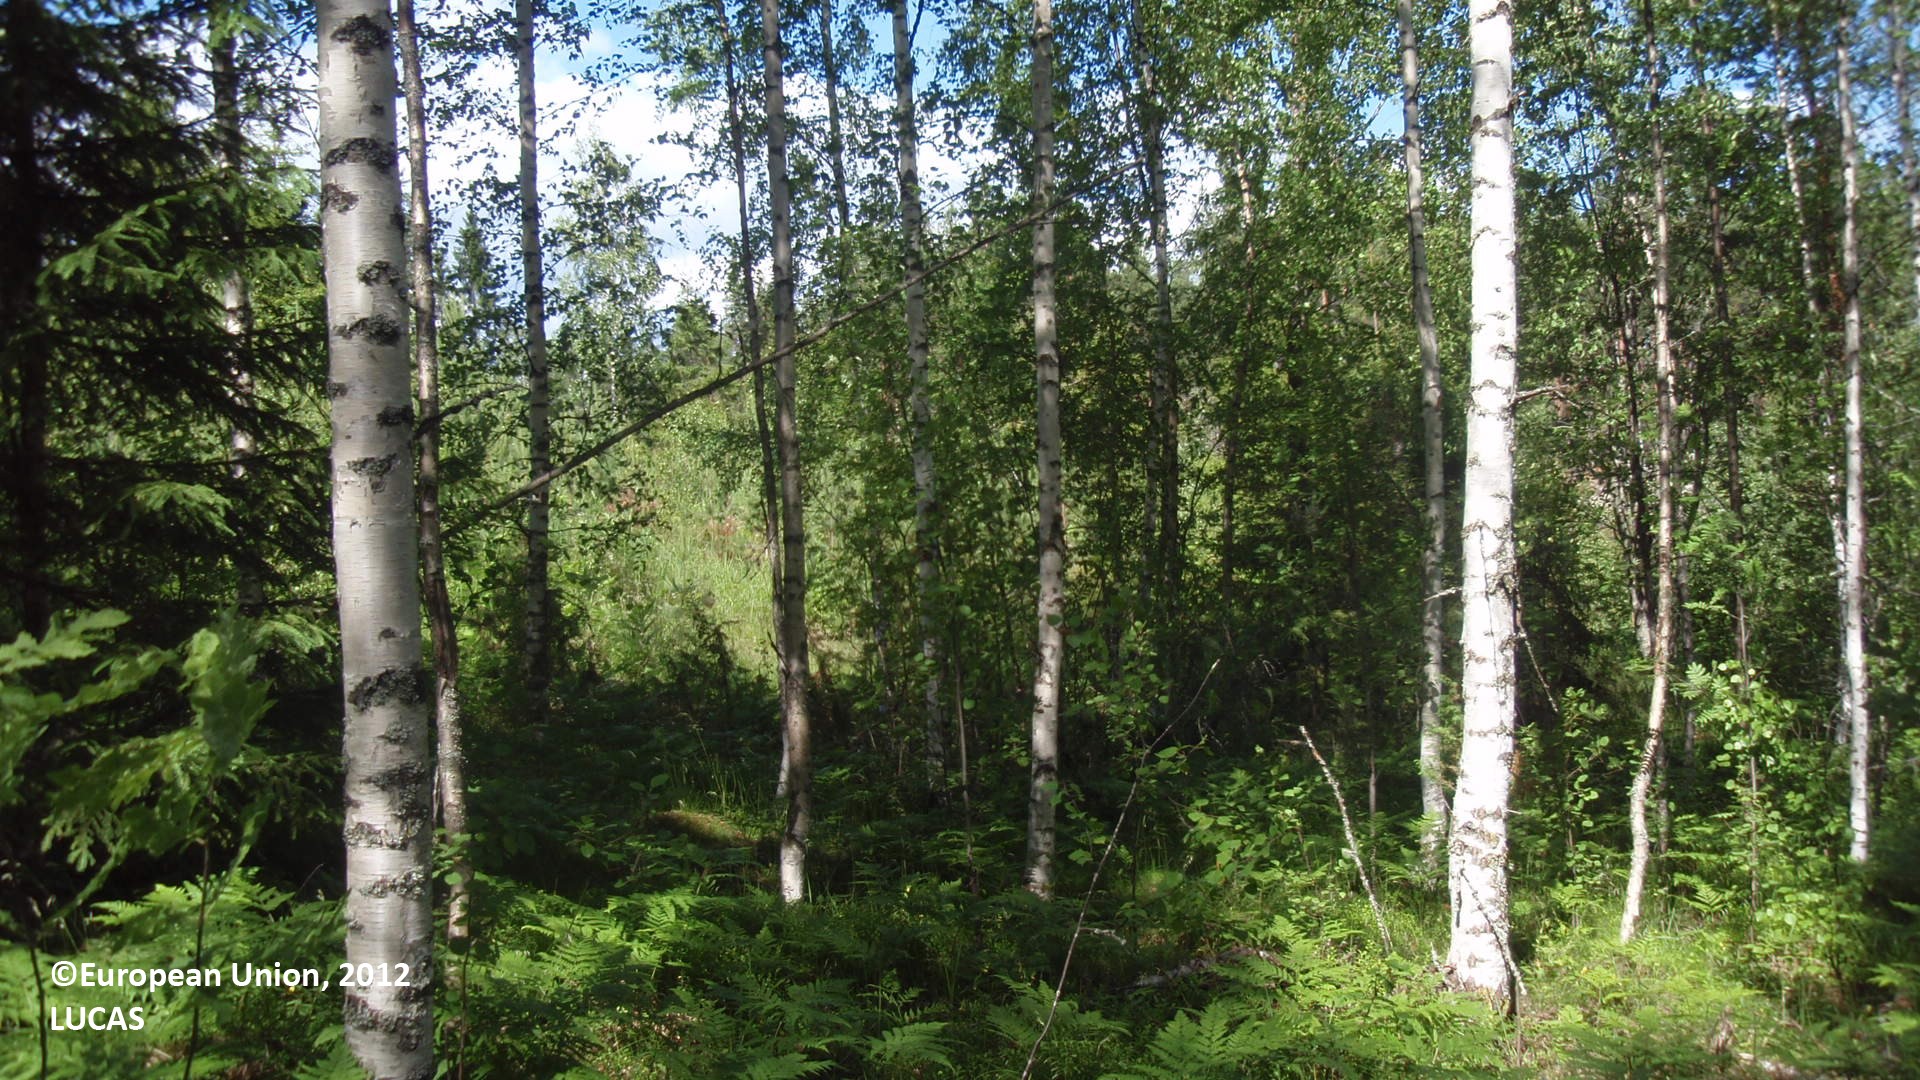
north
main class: Woodland
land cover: Other mixed woodland
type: boreal forest
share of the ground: > 75 %
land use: Forestry
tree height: > 5 m
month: July
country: FI
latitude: 61.7327
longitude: 28.3173
